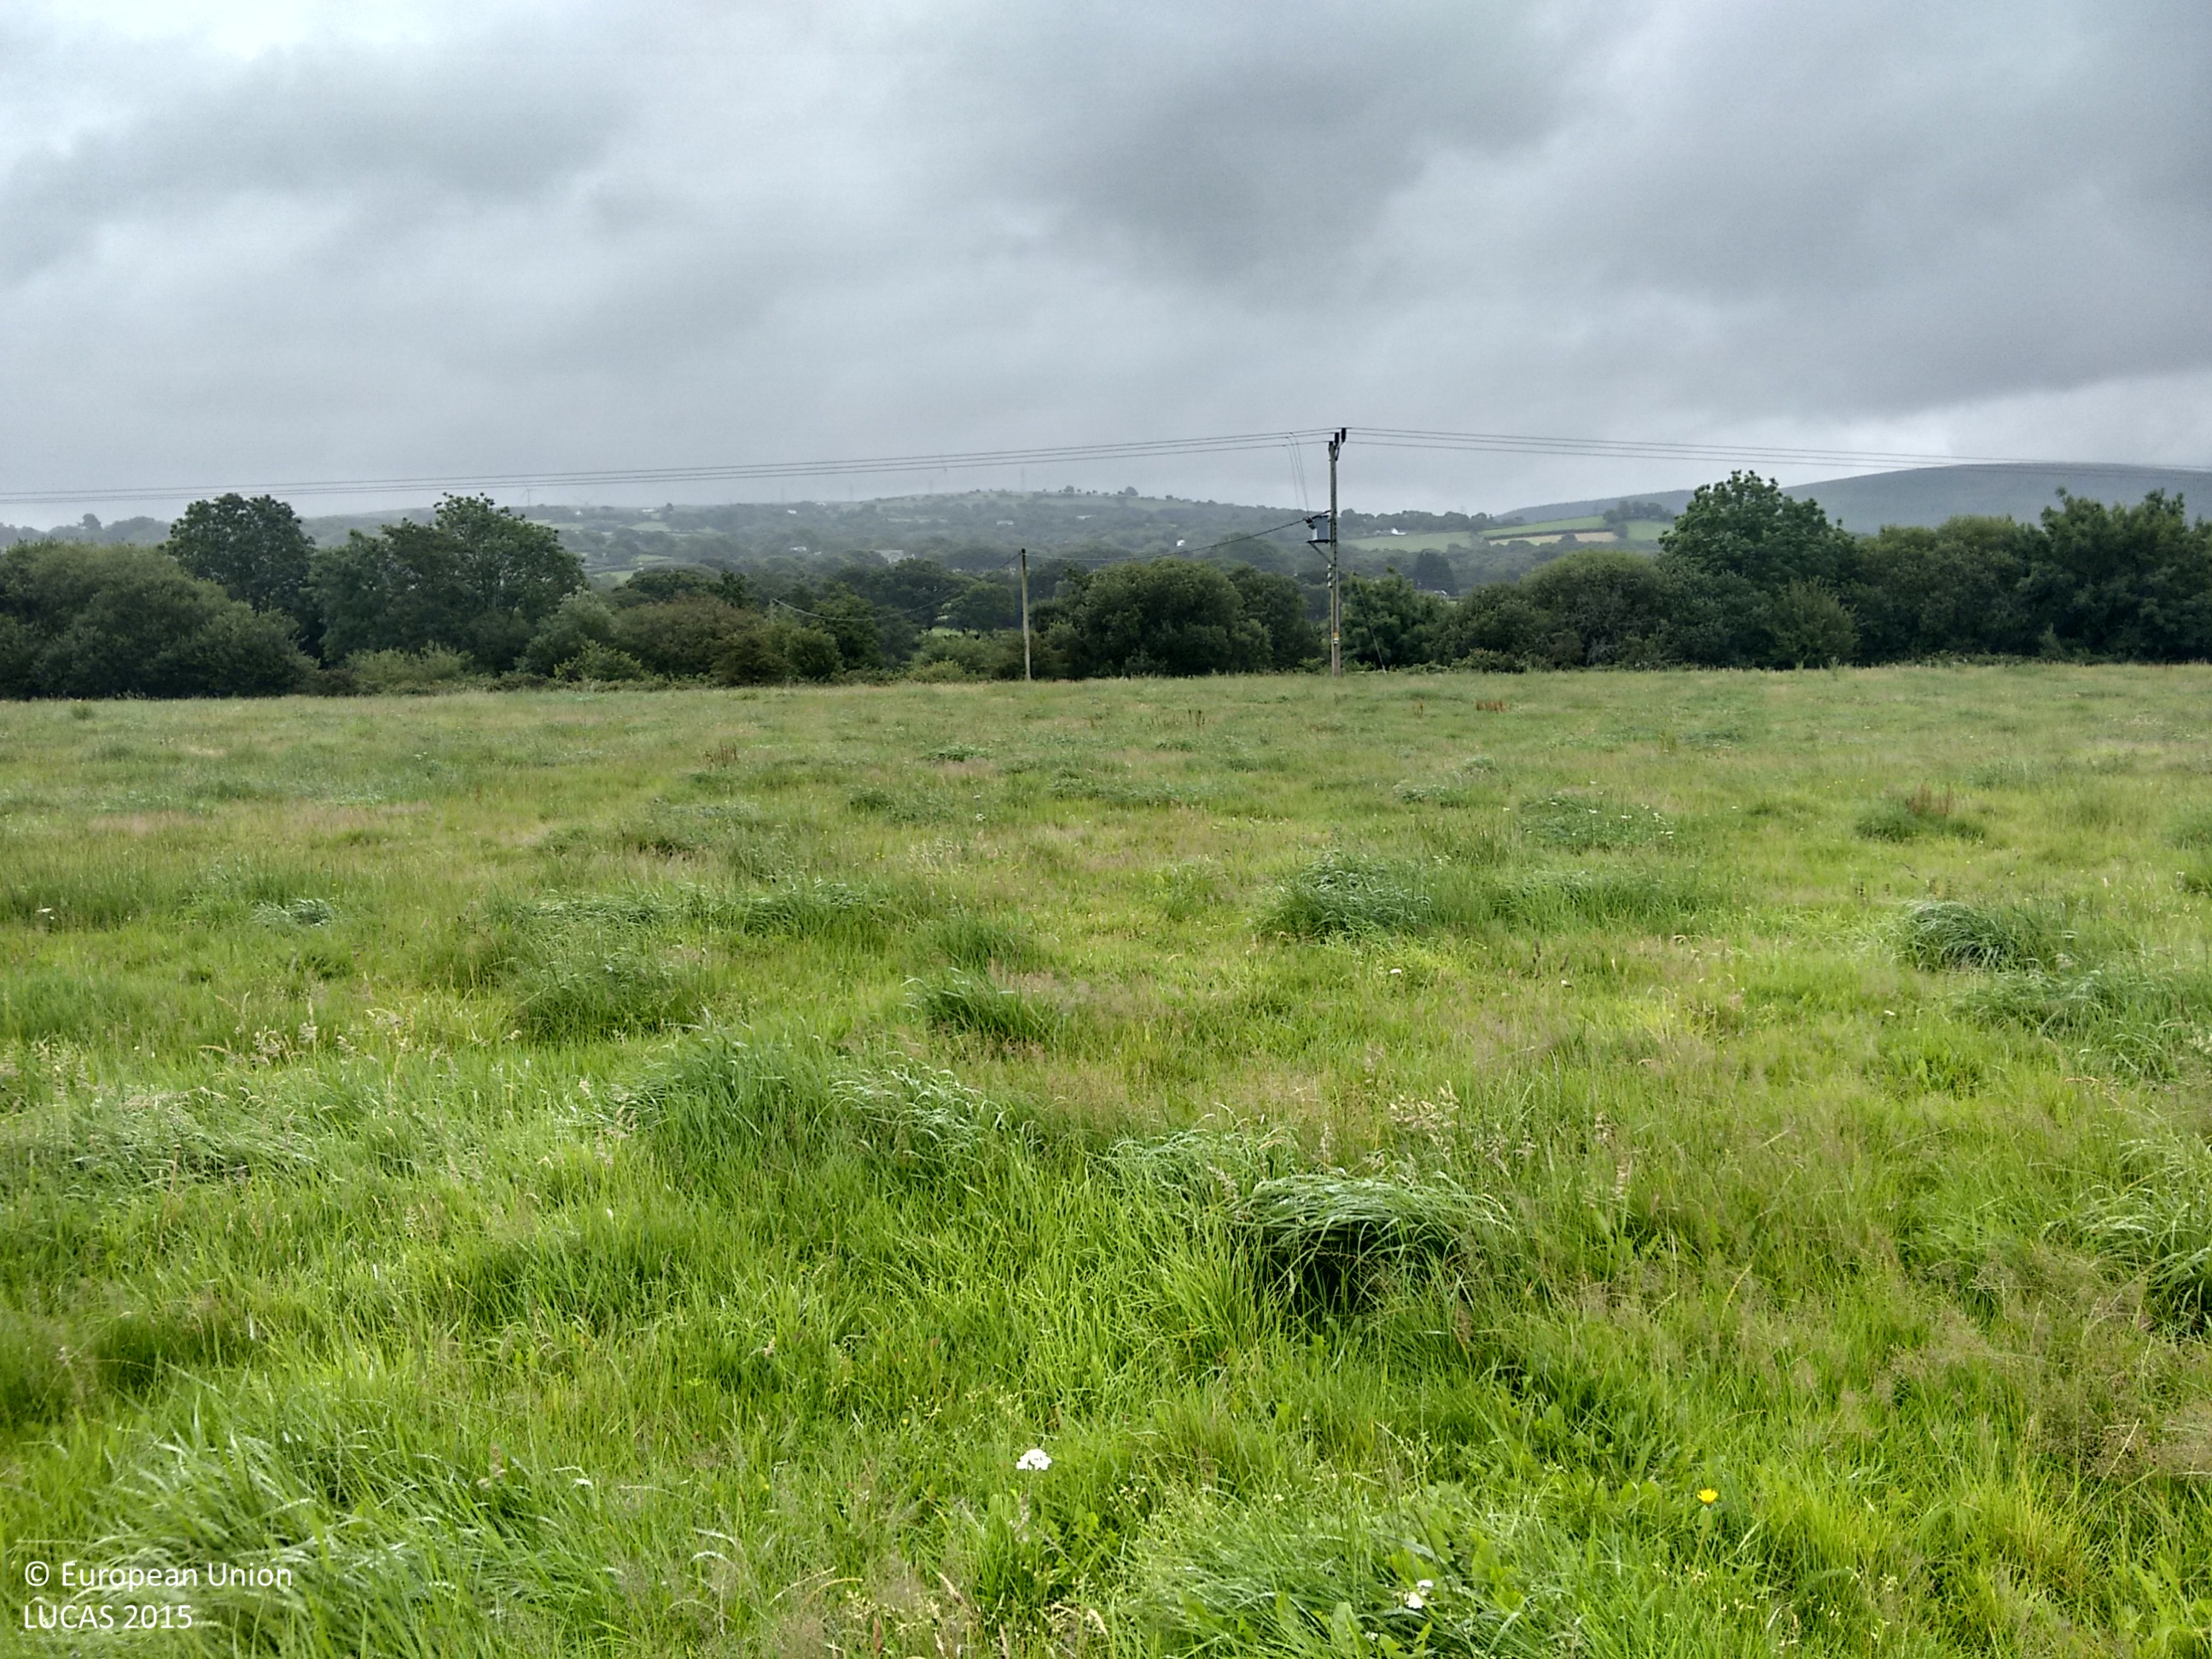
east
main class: Grassland
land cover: Grassland without tree/shrub cover
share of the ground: > 75 %
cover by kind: herbaceous plants 100 %
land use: Agriculture (excluding fallow land and kitchen gardens)
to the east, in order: Grassland without tree/shrub cover; Electric lines; Grassland without tree/shrub cover; Abandoned hedges; Fences; Abandoned hedges; Inland fresh running water; Broadleaved woodland; Tracks; Grassland without tree/shrub cover; Managed hedges; Fences; Managed hedges; Grassland without tree/shrub cover
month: July
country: GB
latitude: 51.7803
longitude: -3.9950
